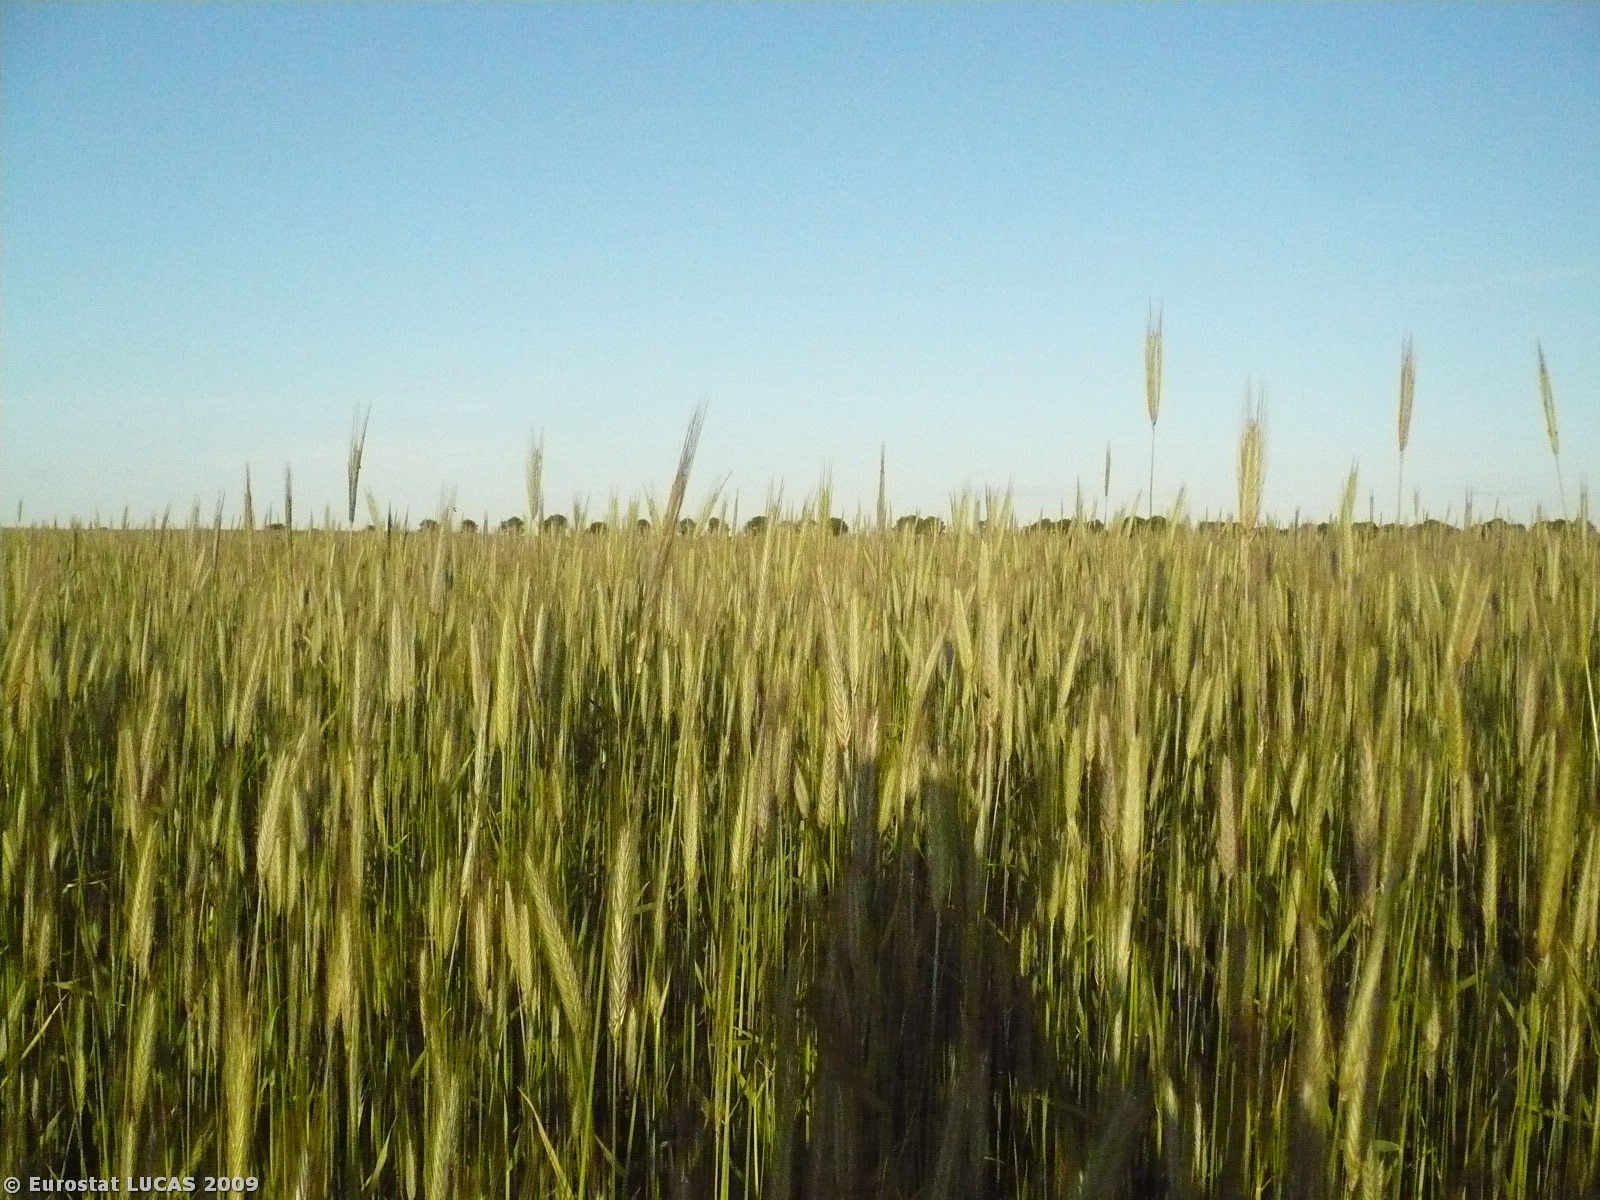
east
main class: Cropland
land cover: Rye
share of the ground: > 75 %
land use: Agriculture (excluding fallow land and kitchen gardens)
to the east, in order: Rye; Barley; Rye; Barley; Rye; Sugar beet
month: May
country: PL
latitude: 52.1721
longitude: 16.3383
